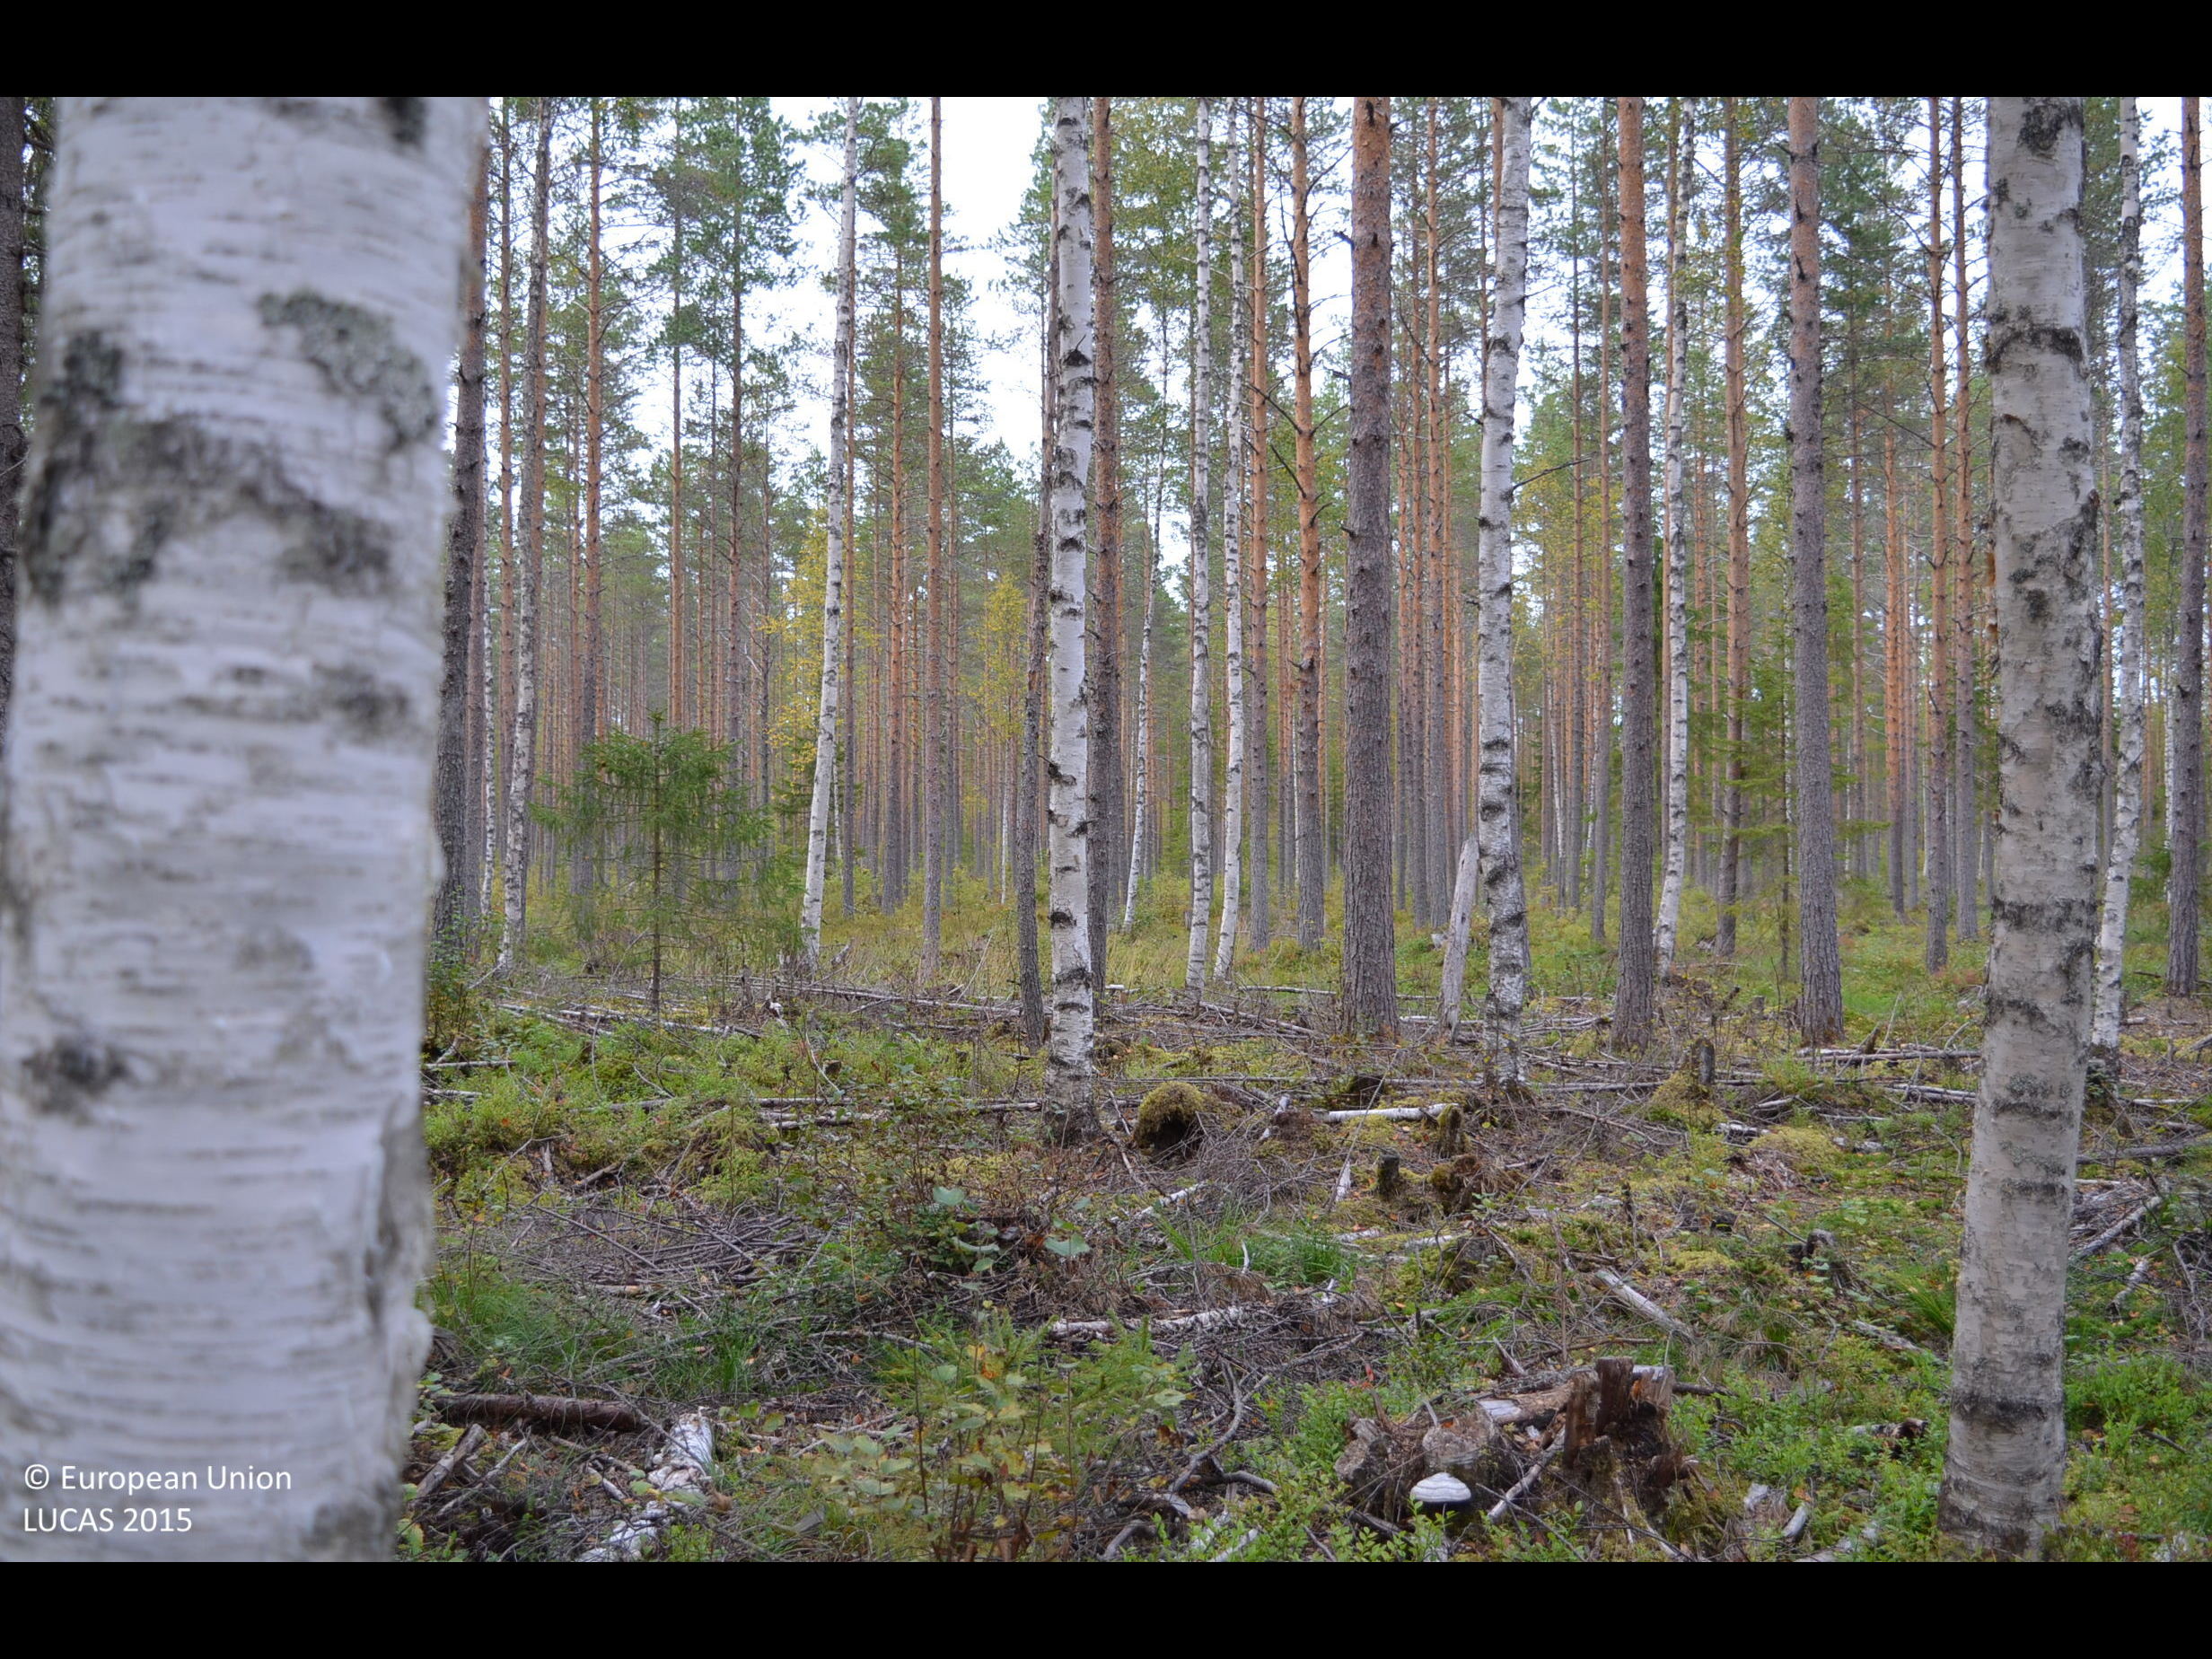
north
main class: Woodland
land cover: Other mixed woodland
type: boreal forest
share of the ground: 50 - 75 %
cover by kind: coniferous forest trees 40 %, broadleaved forest trees 30 %, shrubs 20 %, lichens and mosses 10 %
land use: Forestry
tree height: > 5 m
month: September
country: FI
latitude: 62.8627
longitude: 24.4906
